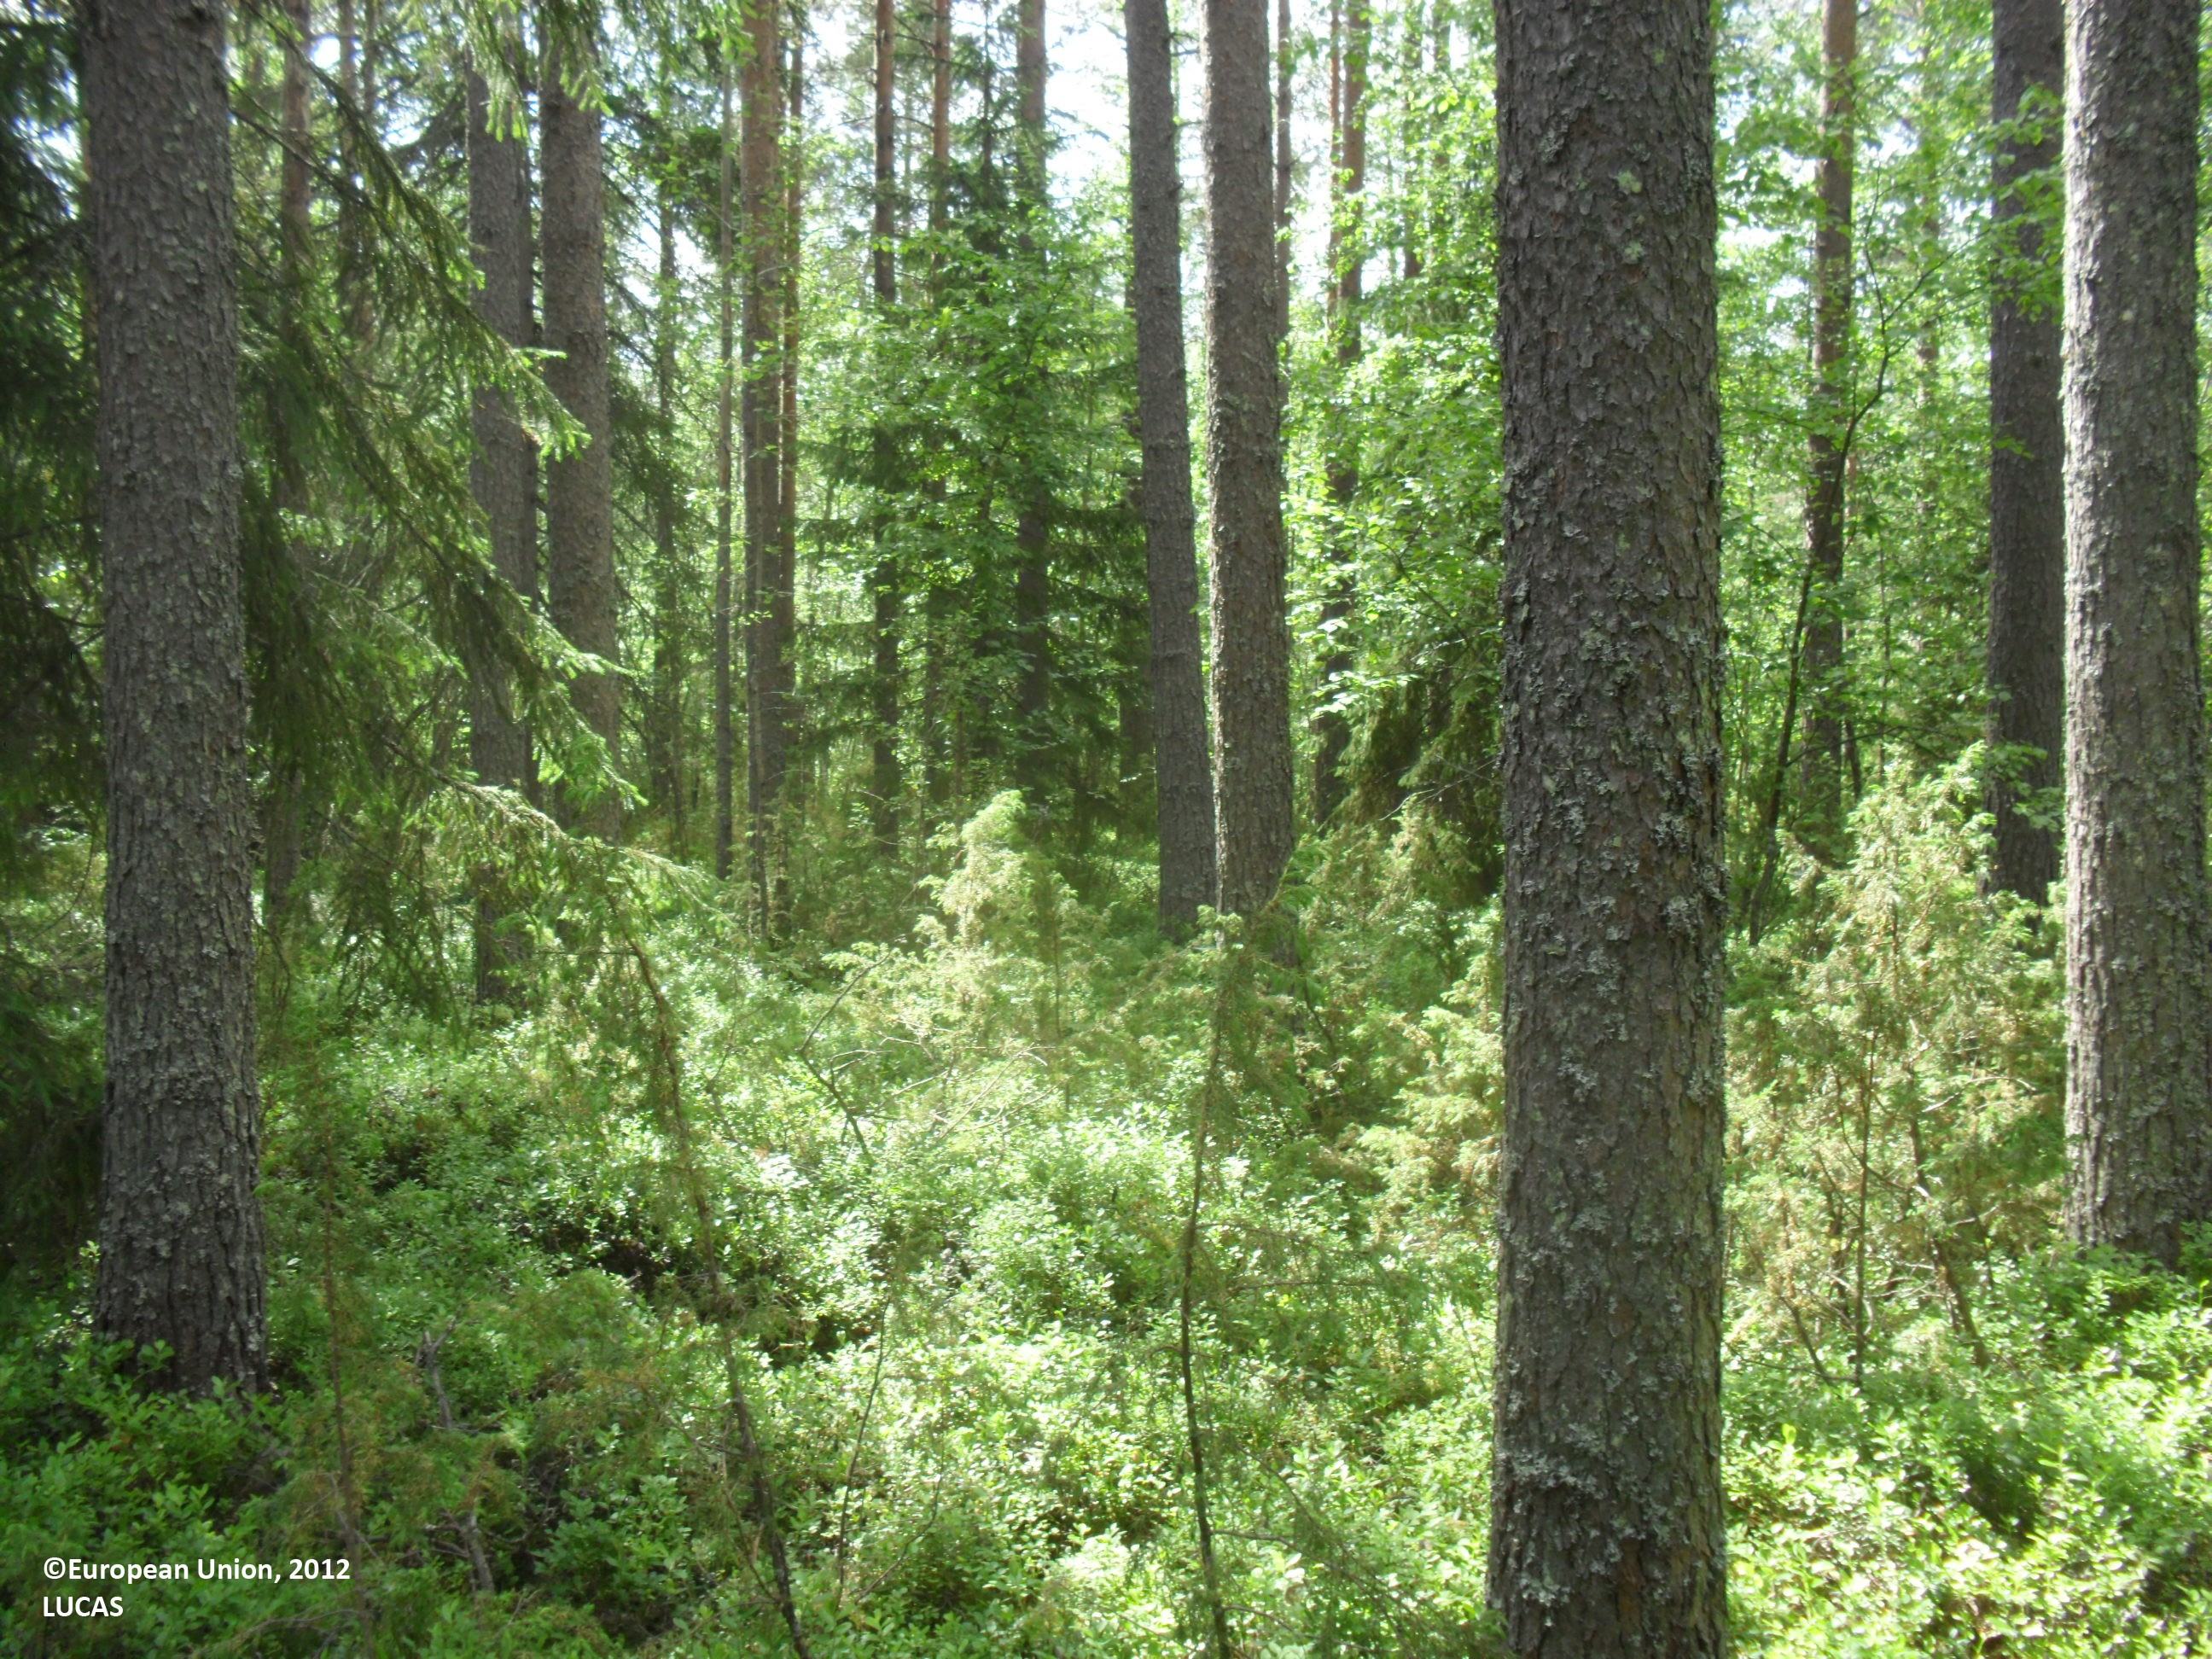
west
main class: Woodland
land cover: Other mixed woodland
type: boreal forest
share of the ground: 50 - 75 %
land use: Forestry
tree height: > 5 m
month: July
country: FI
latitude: 63.5689
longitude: 24.0248
